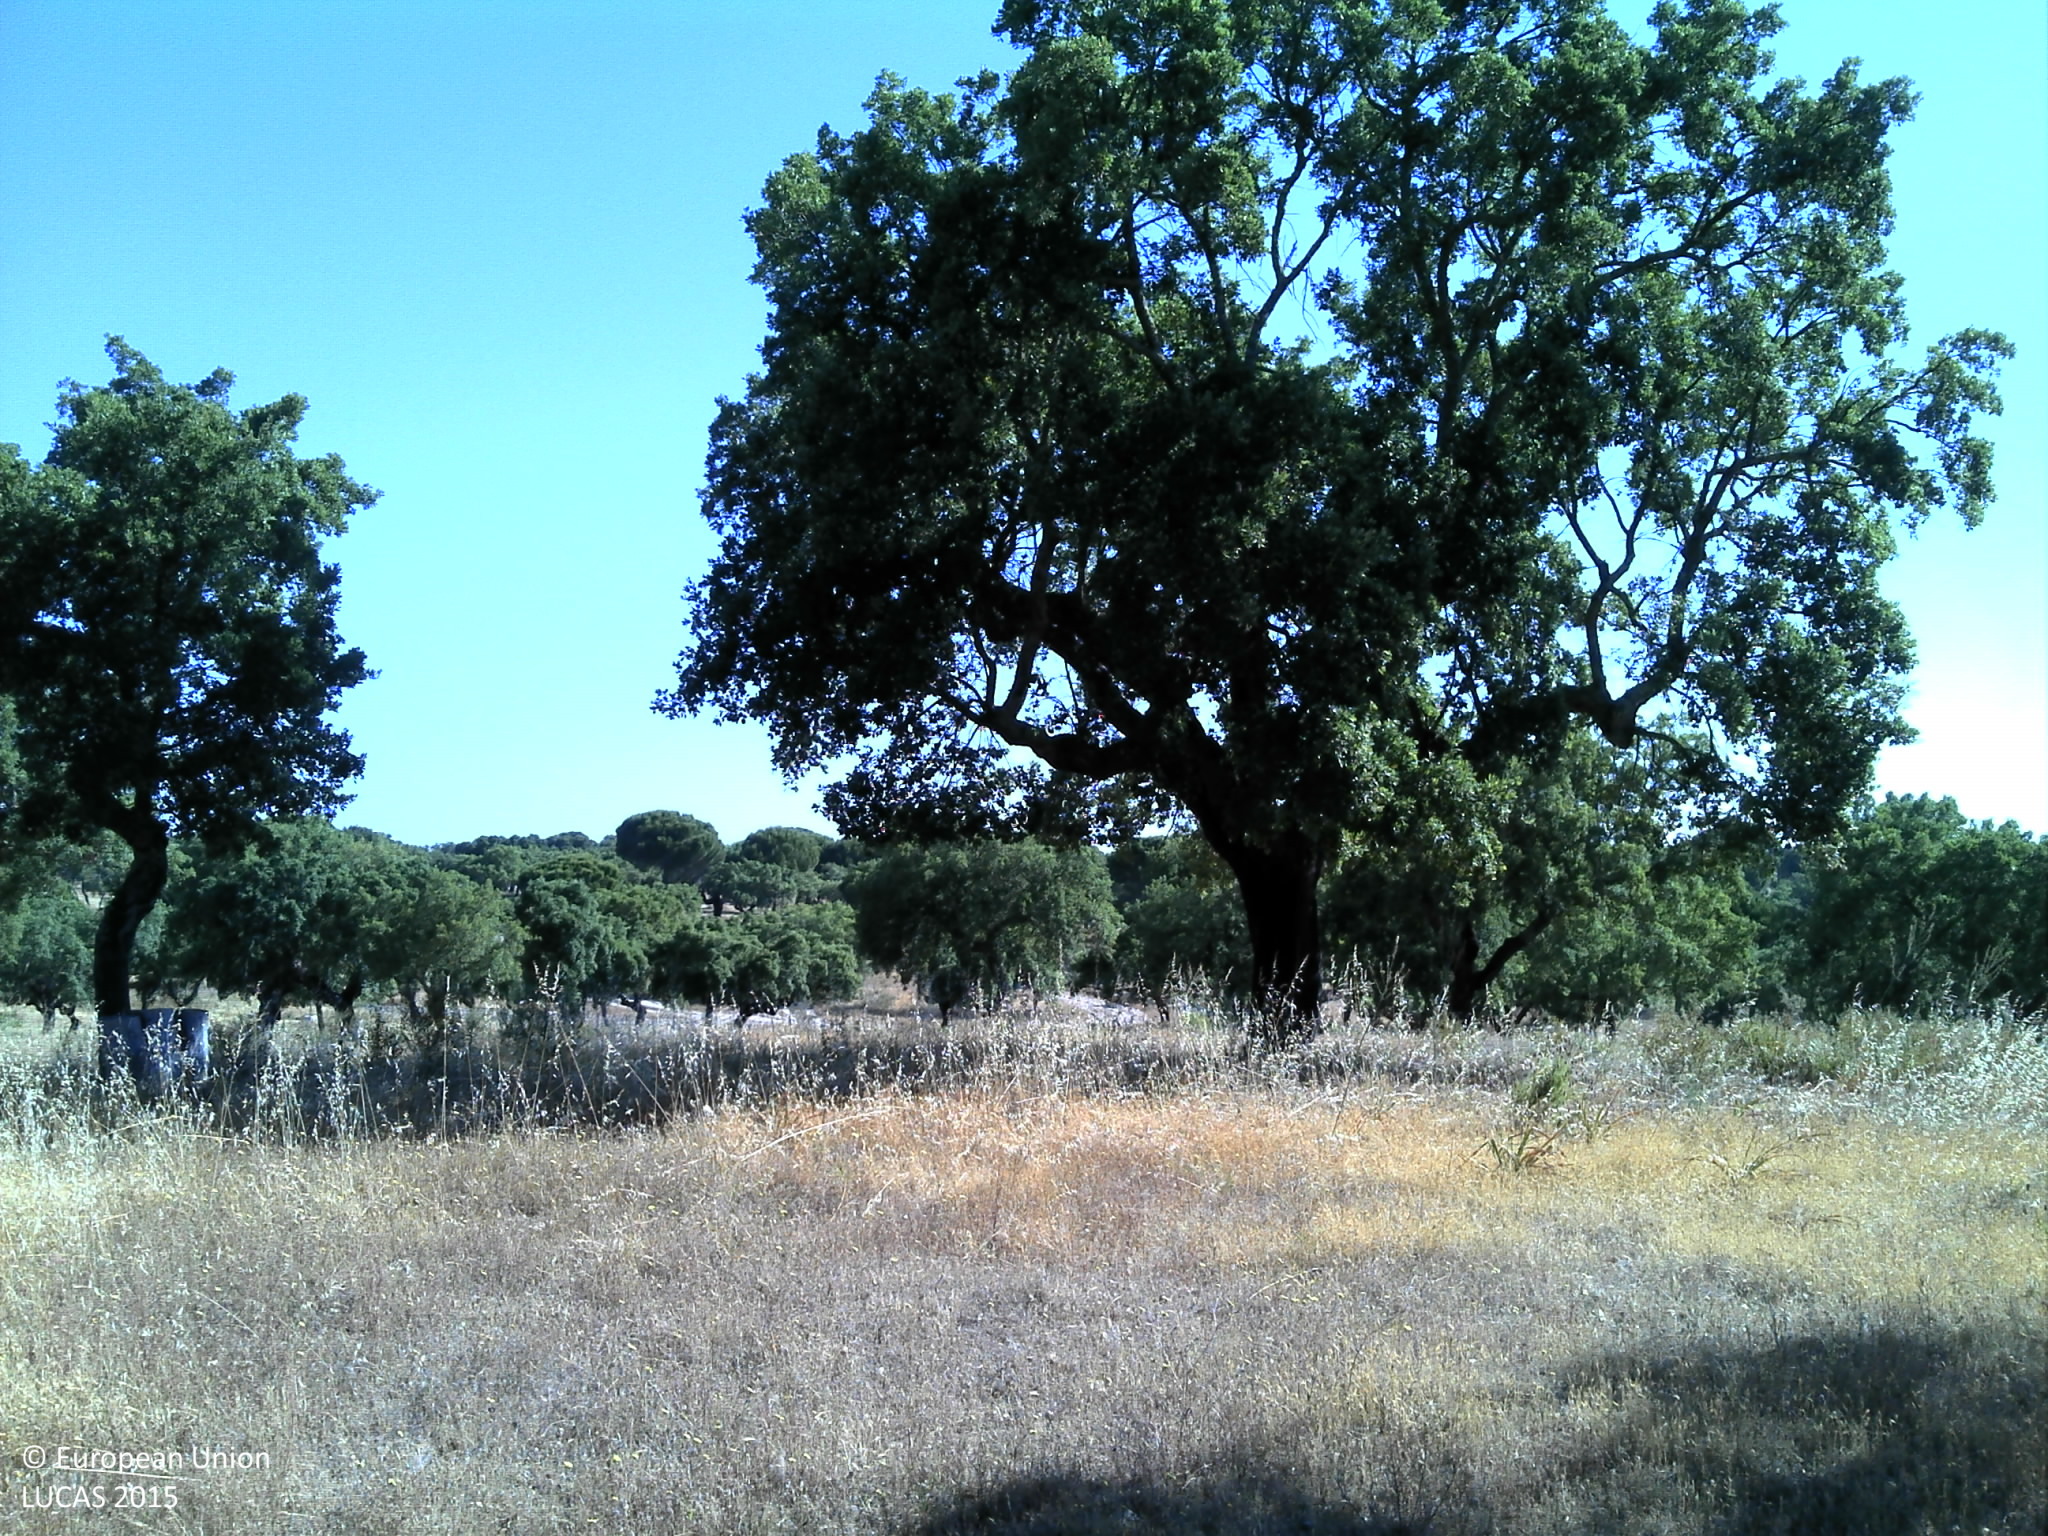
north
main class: Woodland
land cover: Broadleaved woodland
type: broadleaved evergreen forest
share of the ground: 25 - 50 %
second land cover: Grassland without tree/shrub cover
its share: 25 - 50 %
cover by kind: broadleaved forest trees 40 %, herbaceous plants 30 %, unconsolidated bare surface 30 %
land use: Forestry
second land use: Agriculture (excluding fallow land and kitchen gardens)
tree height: > 5 m
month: May
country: PT
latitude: 38.9280
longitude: -8.1508
